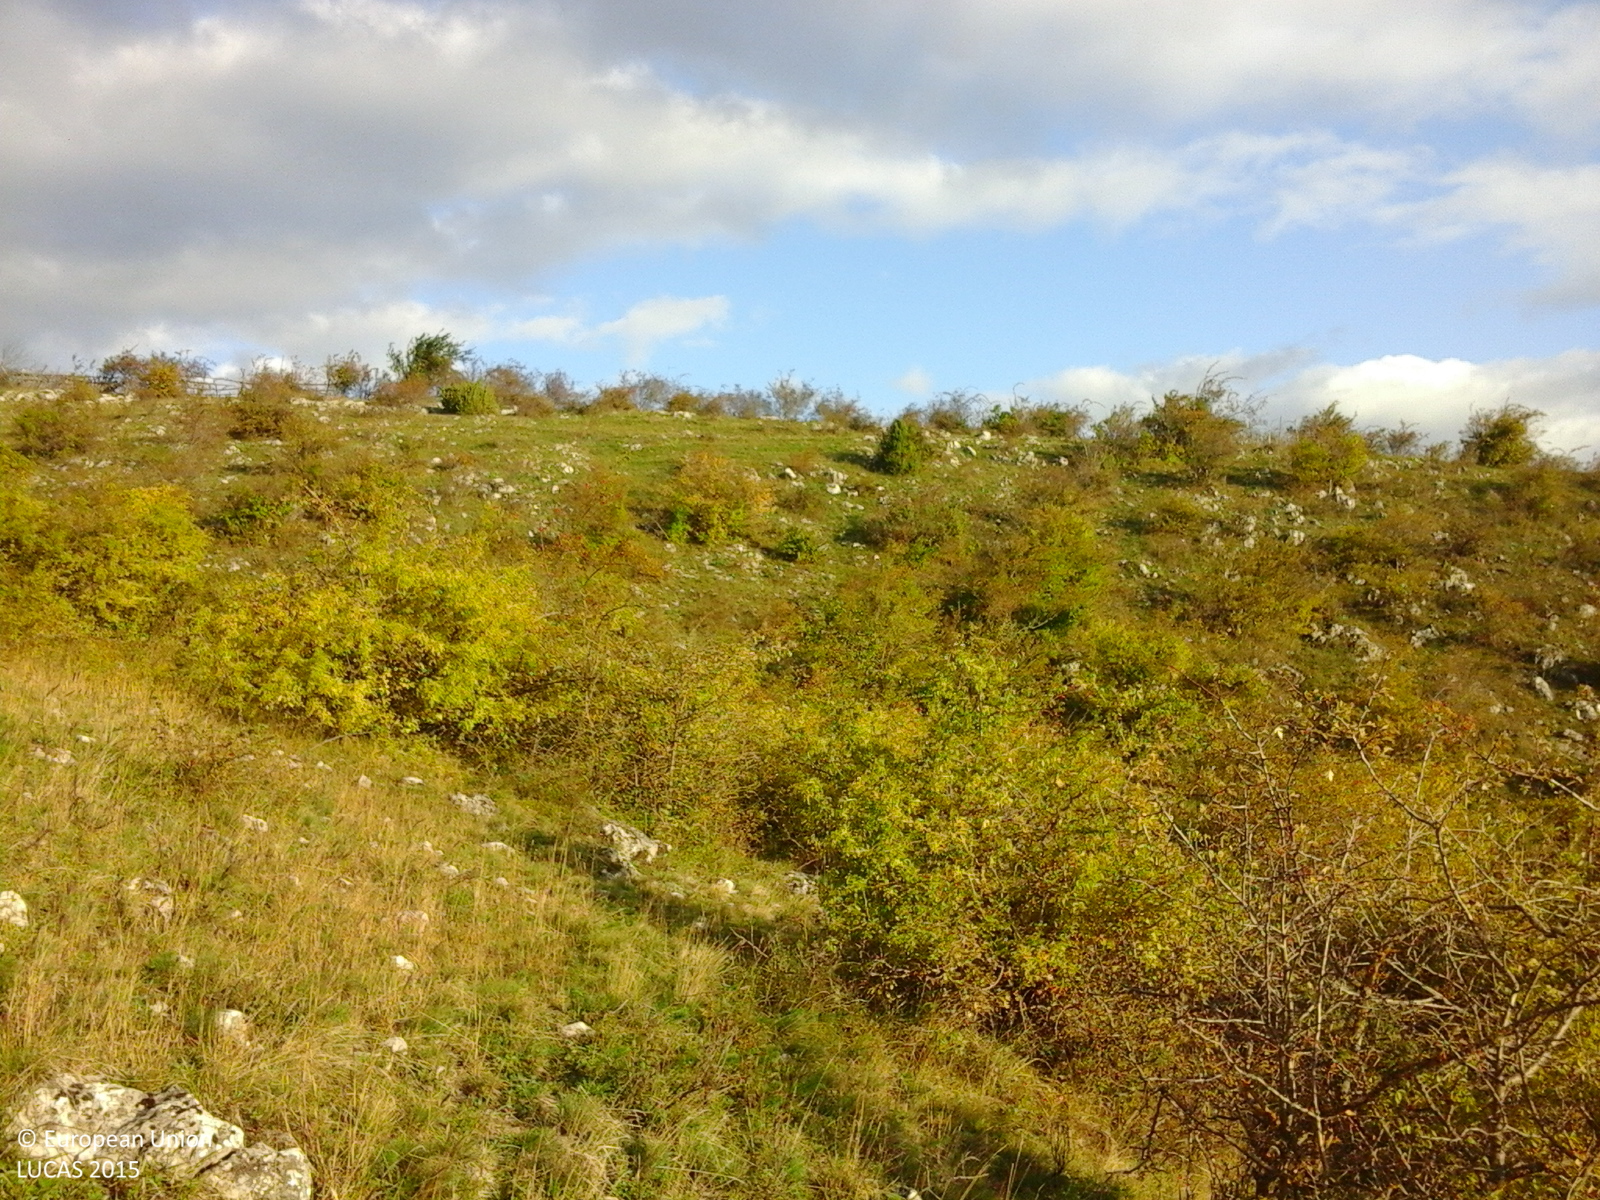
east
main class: Shrubland
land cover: Shrubland with sparse tree cover
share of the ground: > 75 %
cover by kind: shrubs 85 %, herbaceous plants 10 %, broadleaved forest trees 5 %
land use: Semi-natural and natural areas not in use
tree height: < 5 m
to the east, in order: Shrubland with sparse tree cover; Grassland with sparse tree/shrub cover; Fences; Grassland without tree/shrub cover; Other fruit trees and berries; Grassland without tree/shrub cover; Fences; Tracks; Fences; Grassland without tree/shrub cover
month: October
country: RO
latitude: 45.2829
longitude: 25.1474
